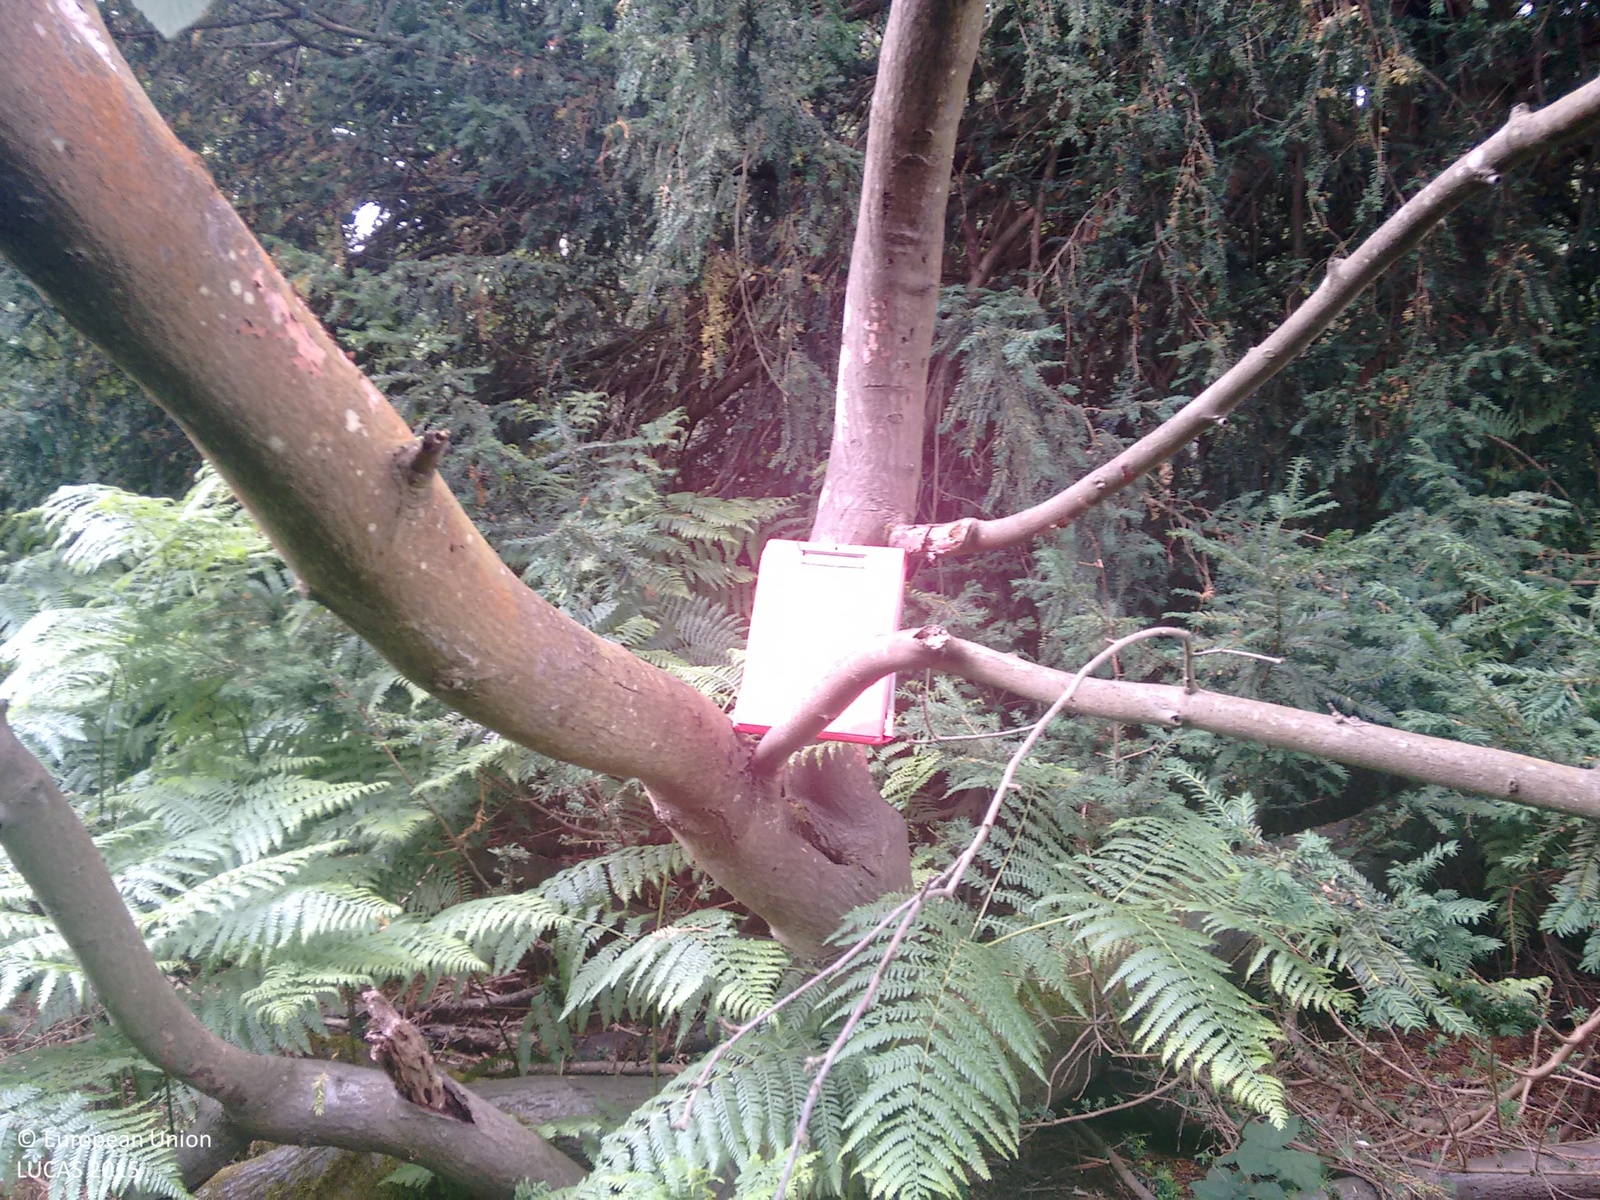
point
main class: Woodland
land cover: Other mixed woodland
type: mesophytic deciduous forest
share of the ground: > 75 %
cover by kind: broadleaved forest trees 60 %, coniferous forest trees 40 %
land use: Forestry
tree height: > 5 m
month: July
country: GB
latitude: 51.2387
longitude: -0.5090
